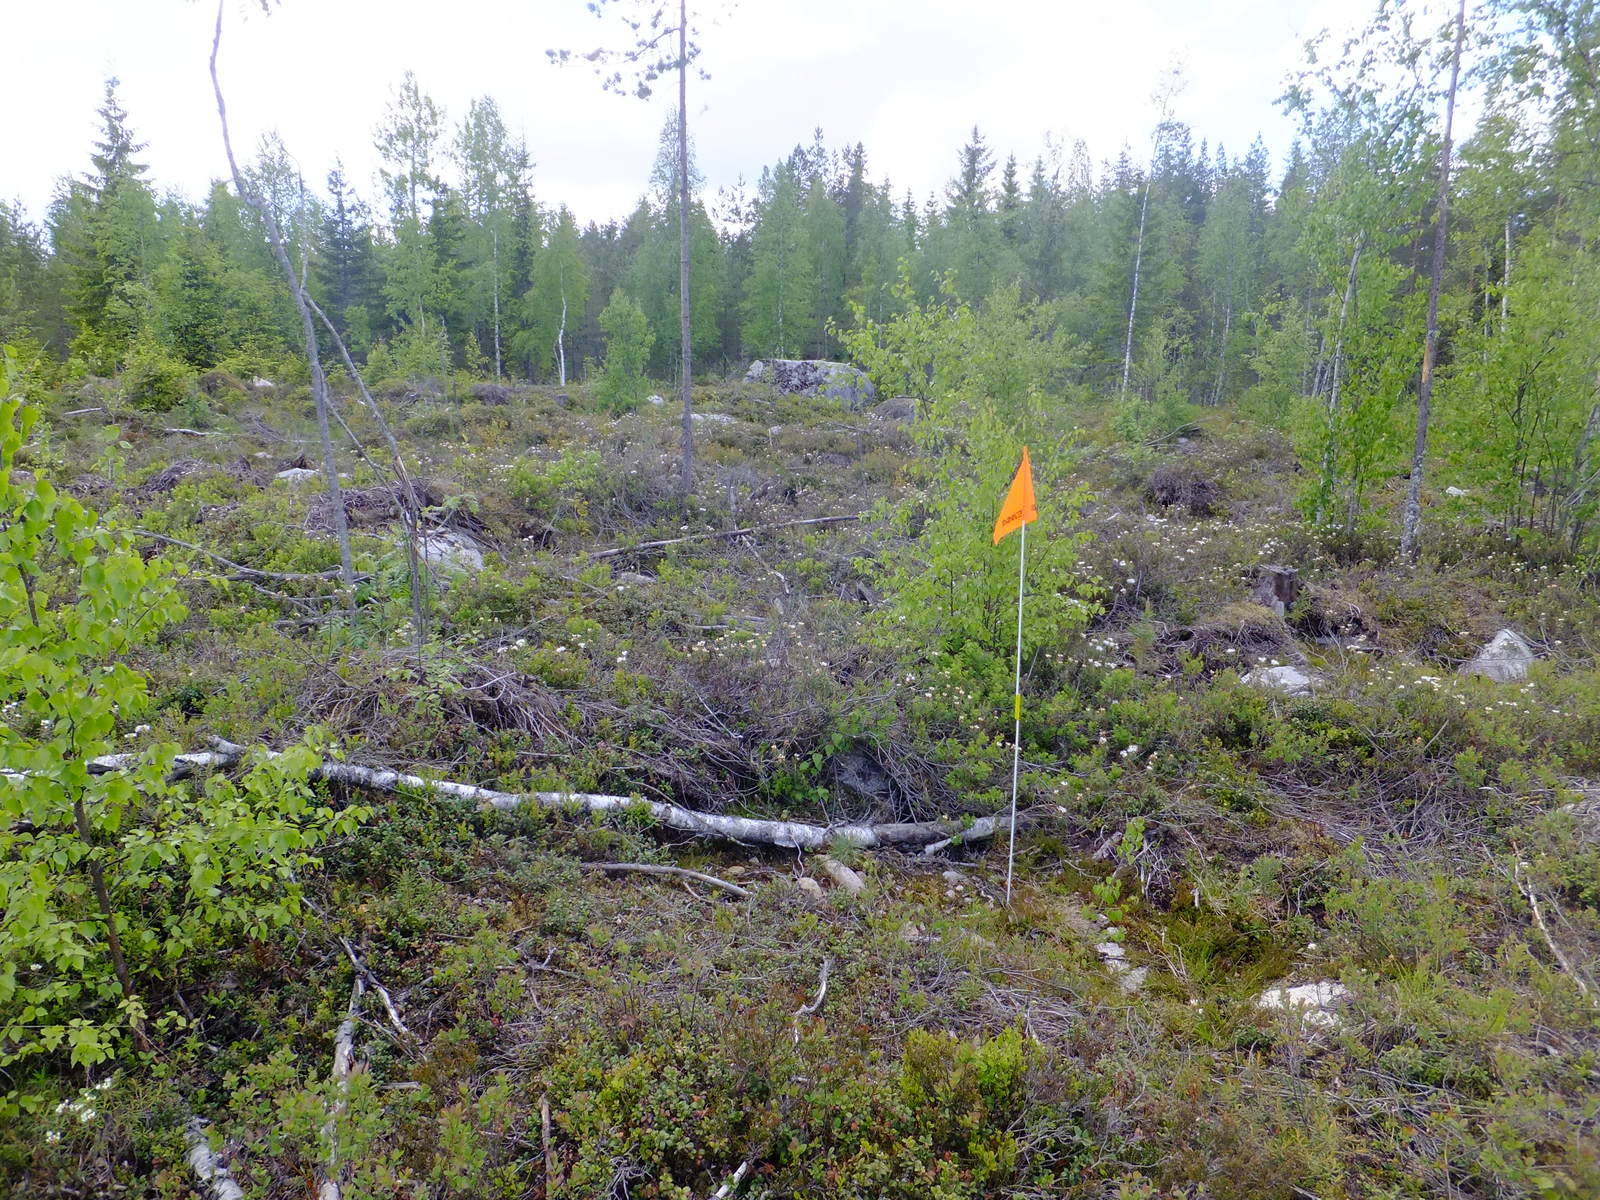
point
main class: Shrubland
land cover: Shrubland with sparse tree cover
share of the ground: > 75 %
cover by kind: shrubs 85 %, broadleaved forest trees 5 %, herbaceous plants 5 %, unconsolidated bare surface 5 %
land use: Forestry
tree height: > 5 m
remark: Clear cut
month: June
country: FI
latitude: 63.4739
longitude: 24.8381
